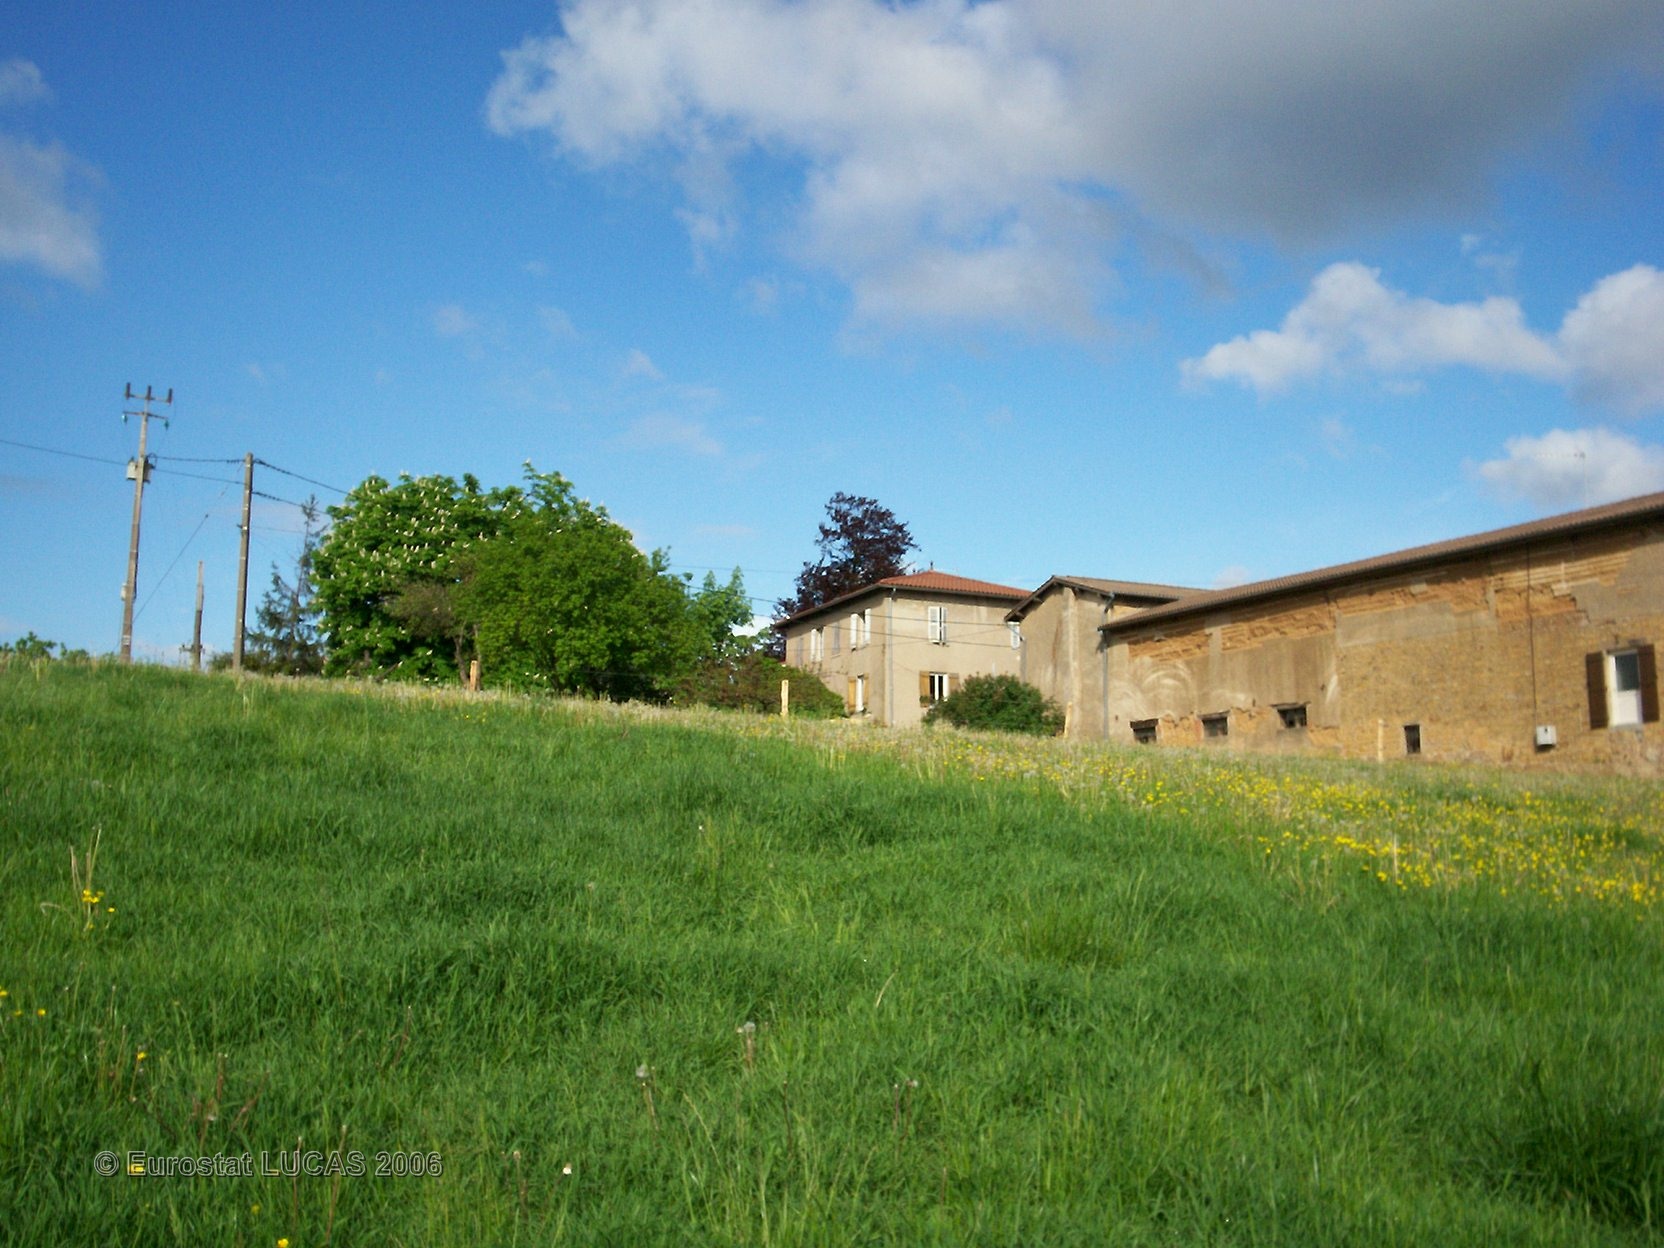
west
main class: Grassland
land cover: Grassland without tree/shrub cover
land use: Agriculture (excluding fallow land and kitchen gardens)
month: May
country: FR
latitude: 45.8618
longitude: 4.7609
